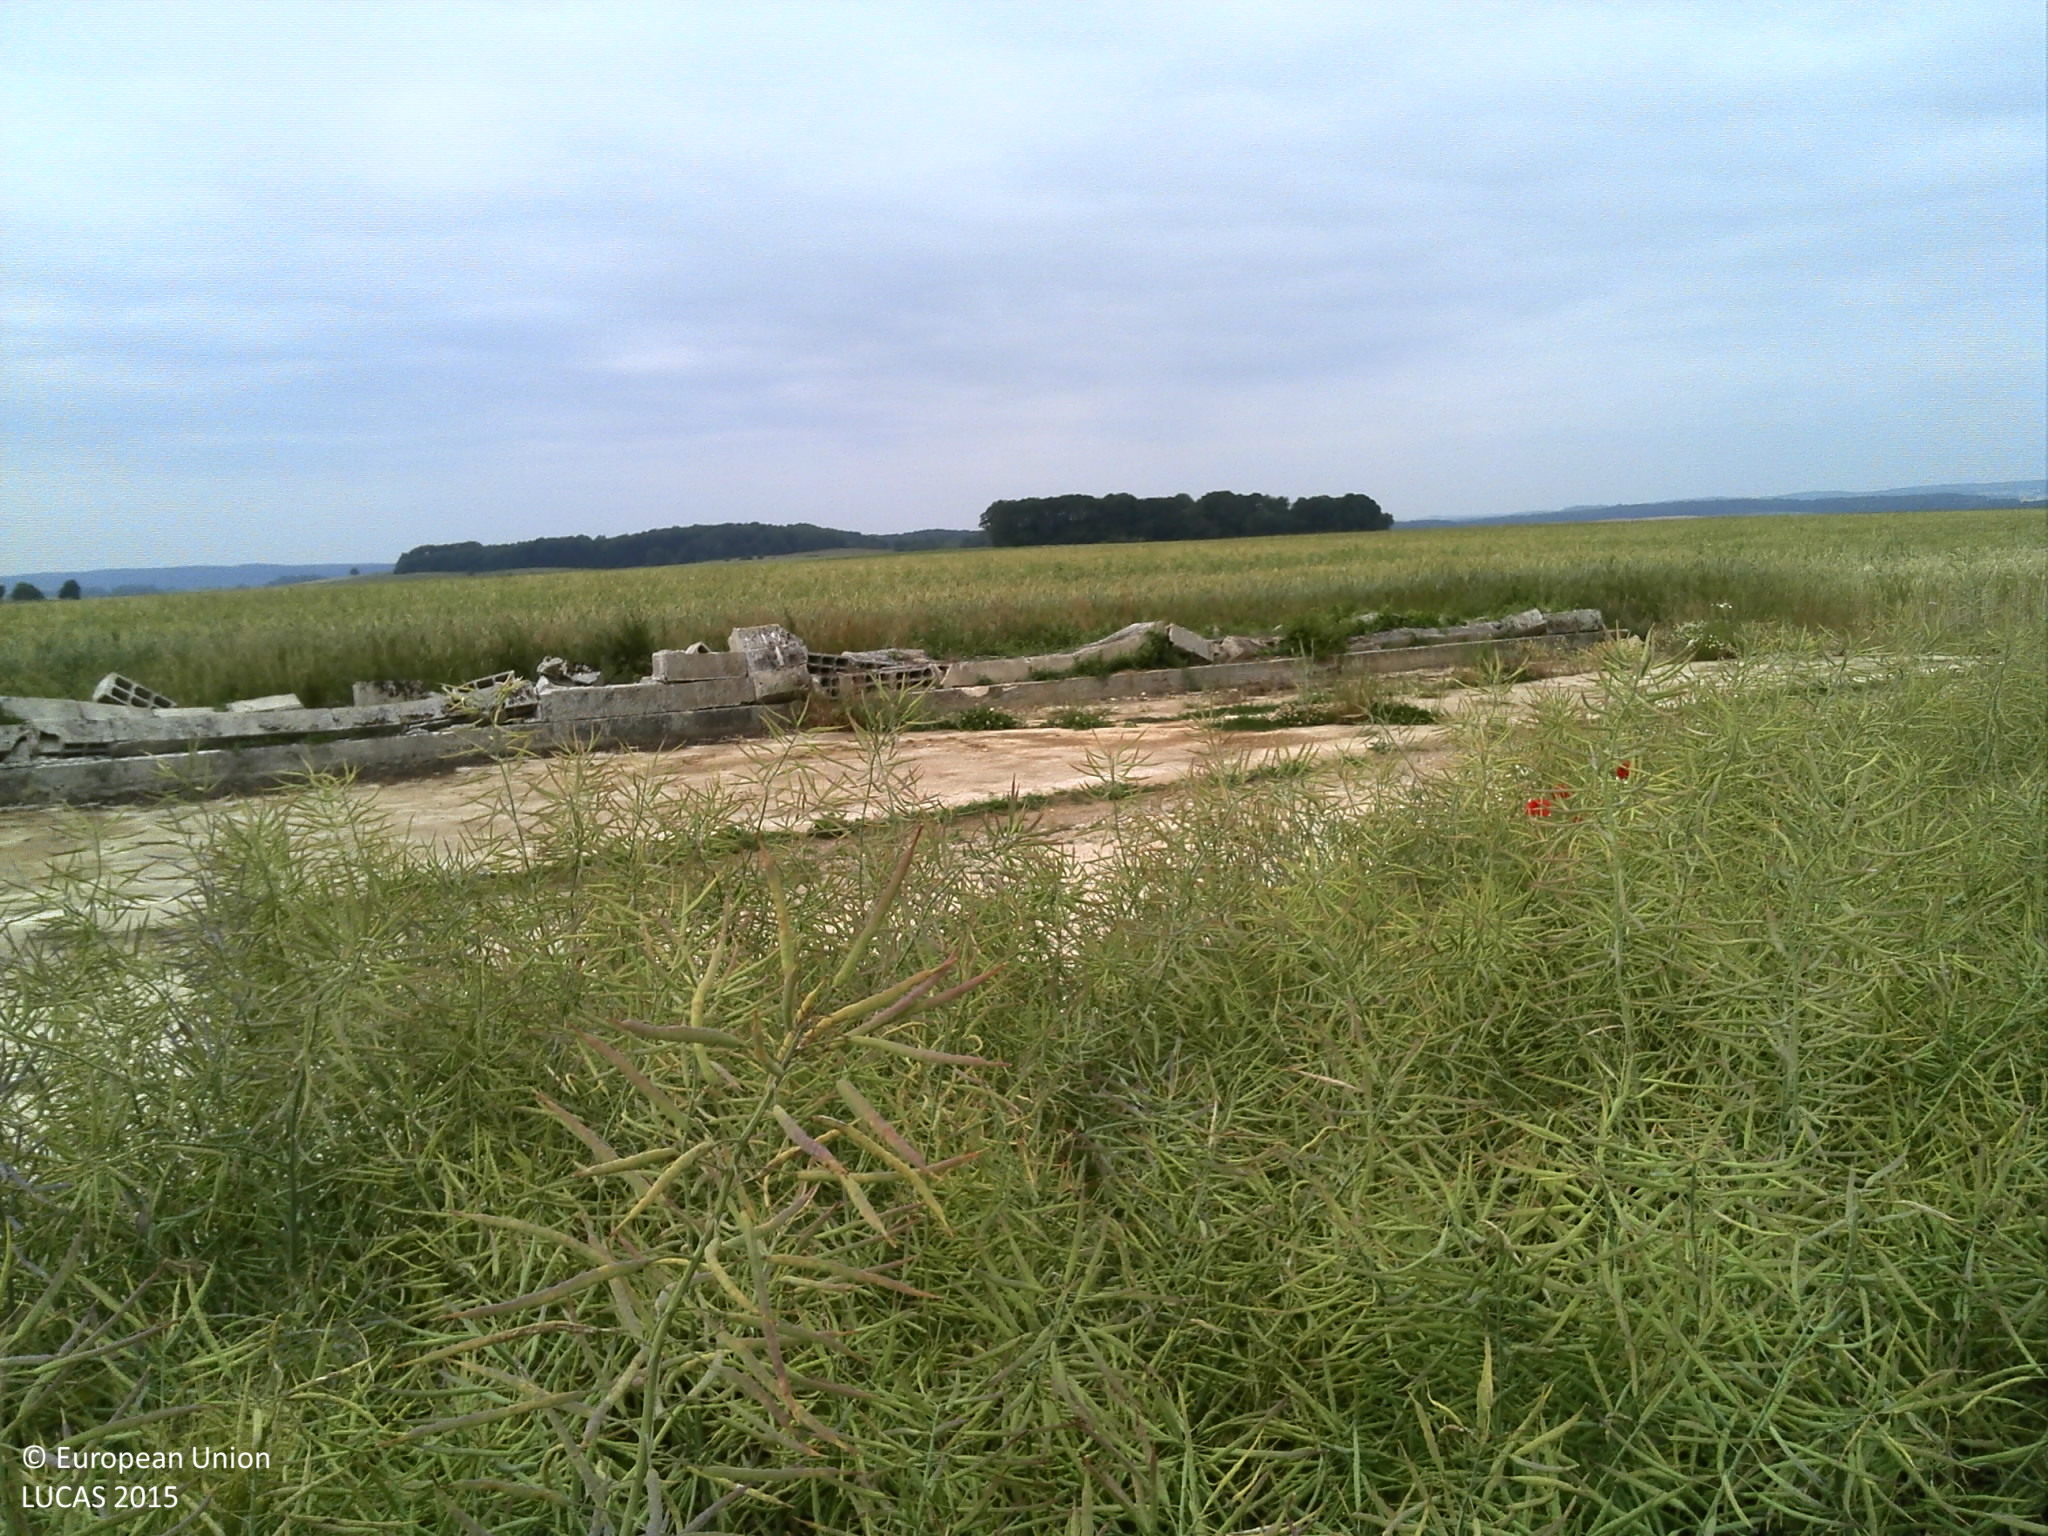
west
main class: Cropland
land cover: Rape and turnip rape
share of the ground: > 75 %
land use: Agriculture (excluding fallow land and kitchen gardens)
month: June
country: FR
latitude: 49.3730
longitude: 5.0259
